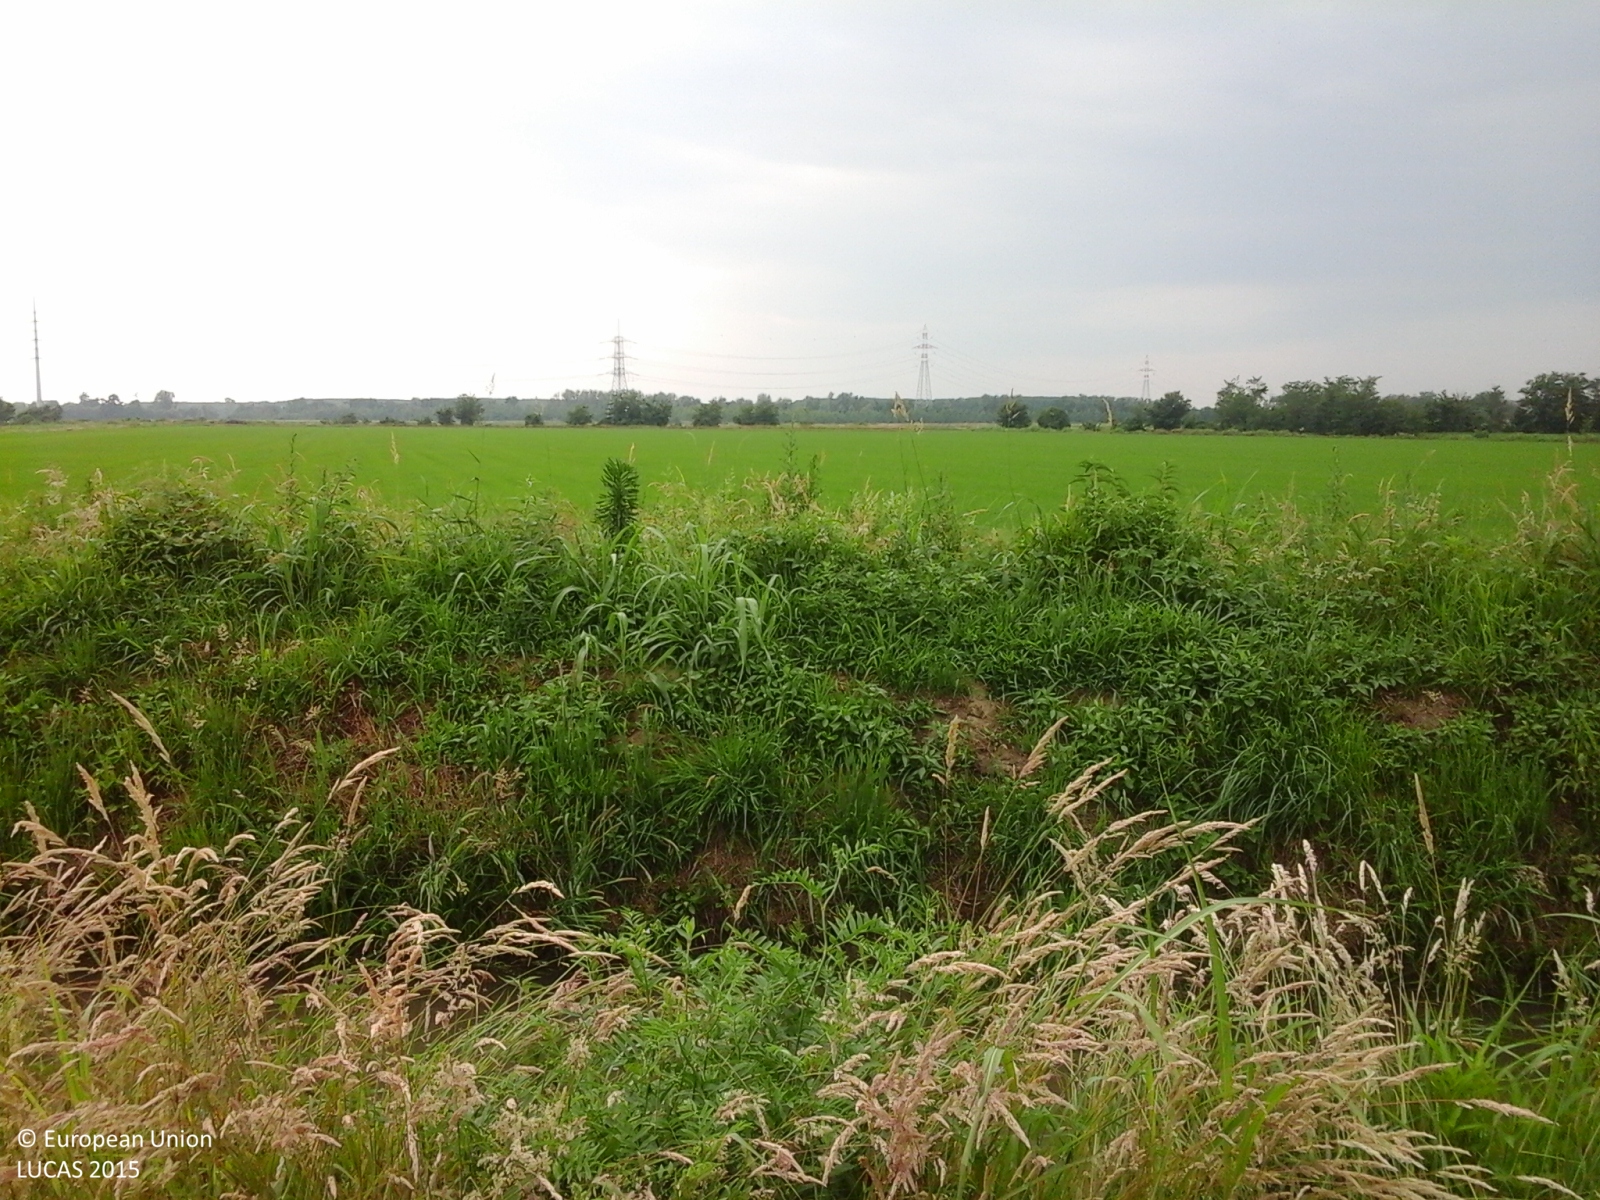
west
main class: Cropland
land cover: Rice
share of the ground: > 75 %
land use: Agriculture (excluding fallow land and kitchen gardens)
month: June
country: IT
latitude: 45.2783
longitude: 8.5620
